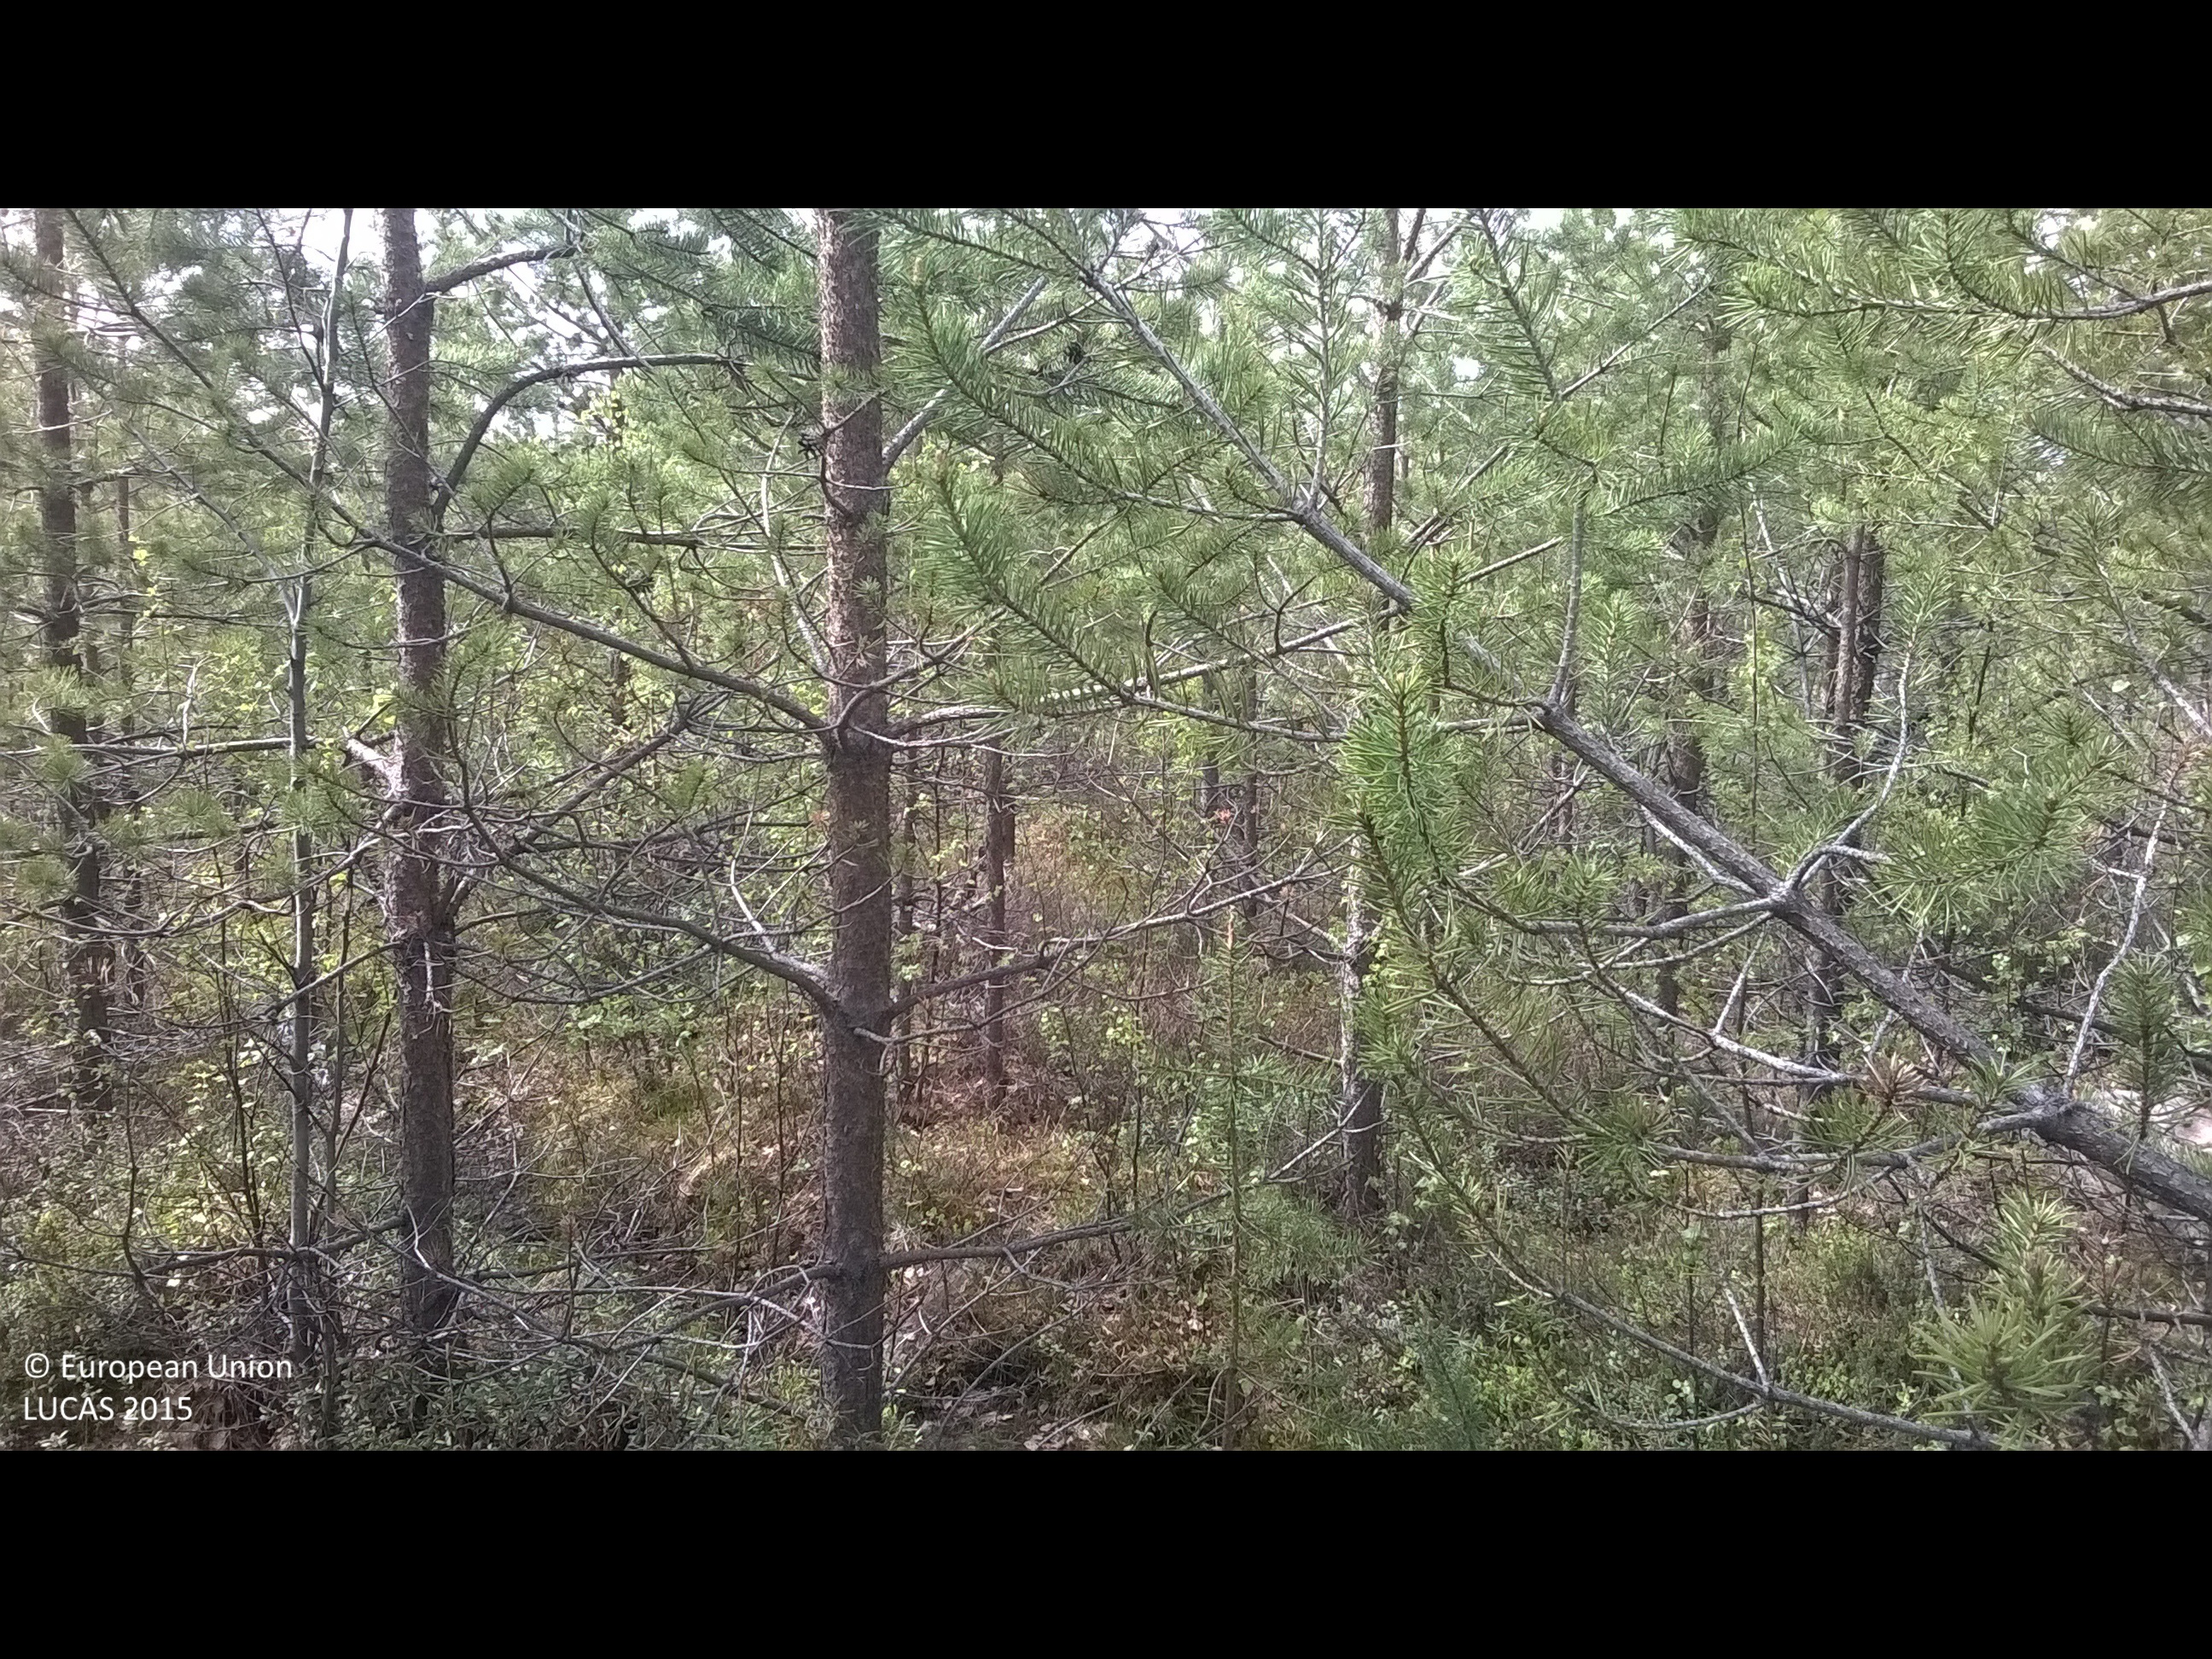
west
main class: Woodland
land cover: Pine dominated coniferous woodland
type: boreal forest
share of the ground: > 75 %
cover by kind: coniferous forest trees 90 %, broadleaved forest trees 5 %, shrubs 5 %
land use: Forestry
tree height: < 5 m
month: June
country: FI
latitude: 66.5653
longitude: 26.5591
